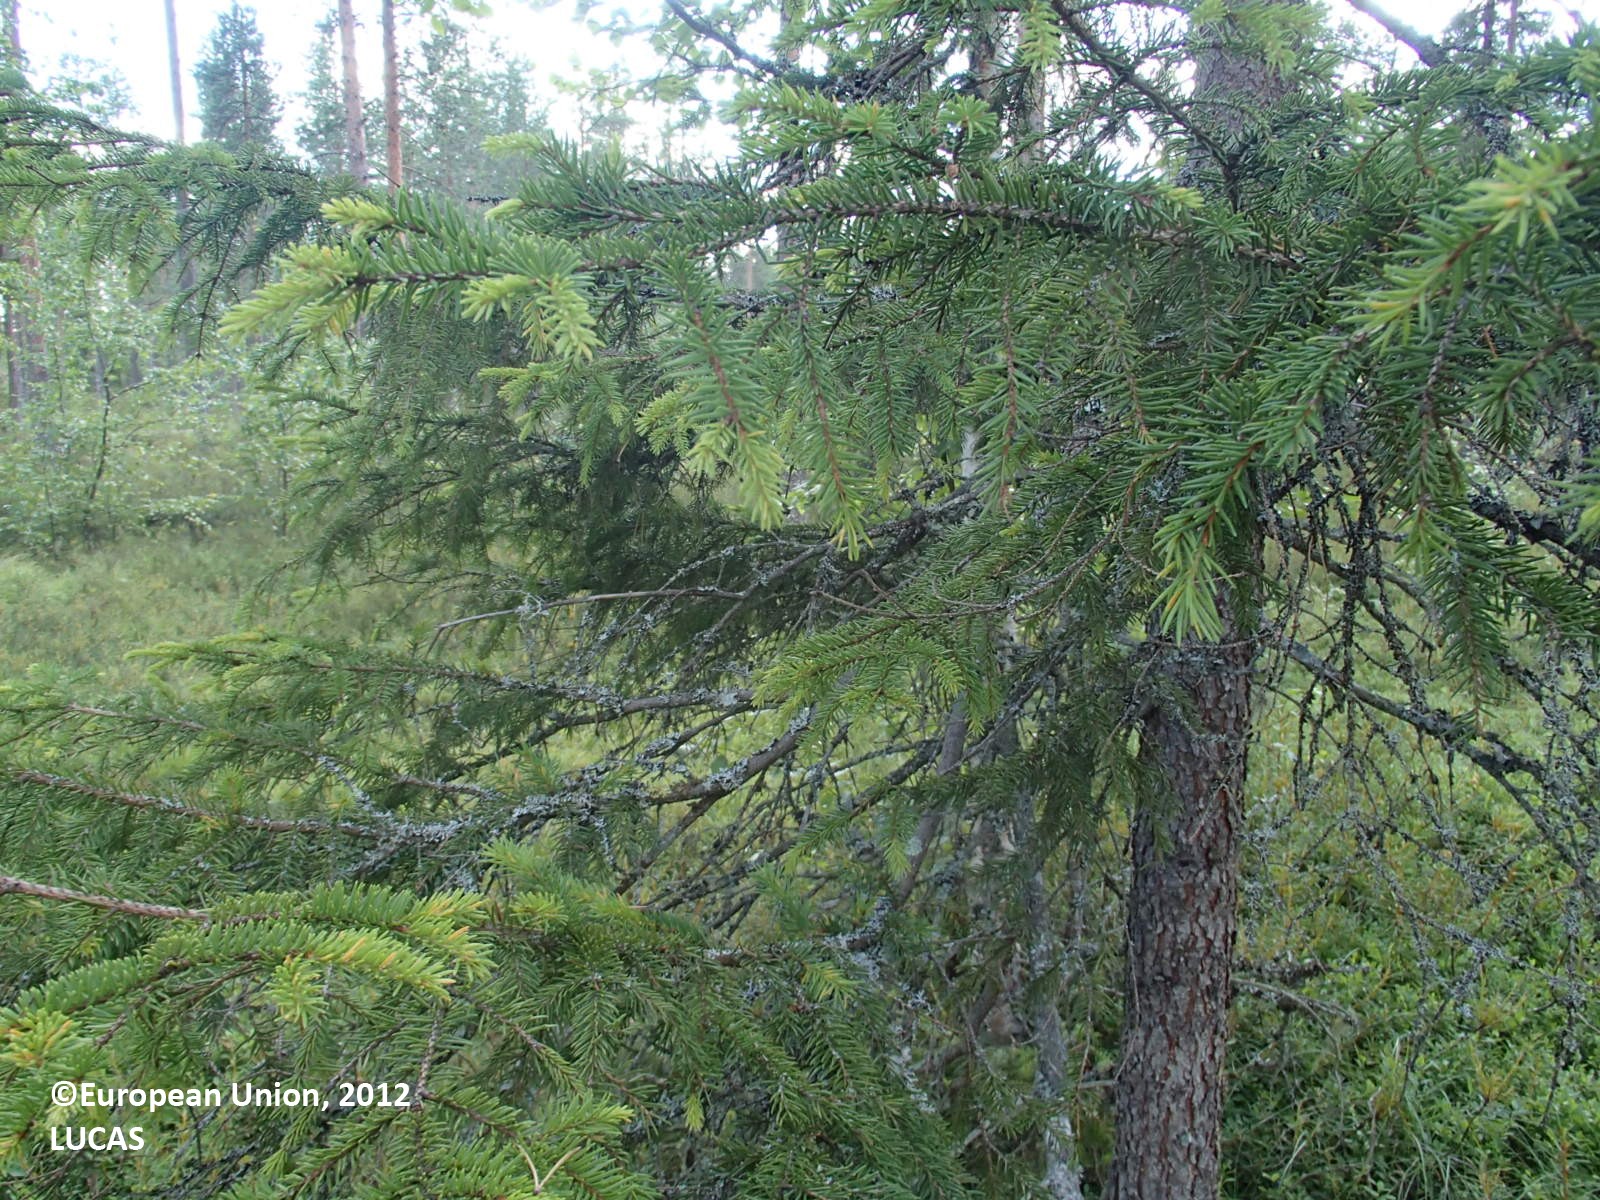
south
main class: Woodland
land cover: Pine dominated mixed woodland
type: boreal forest
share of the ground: > 75 %
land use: Forestry
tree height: > 5 m
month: July
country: FI
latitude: 63.9465
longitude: 27.3908
